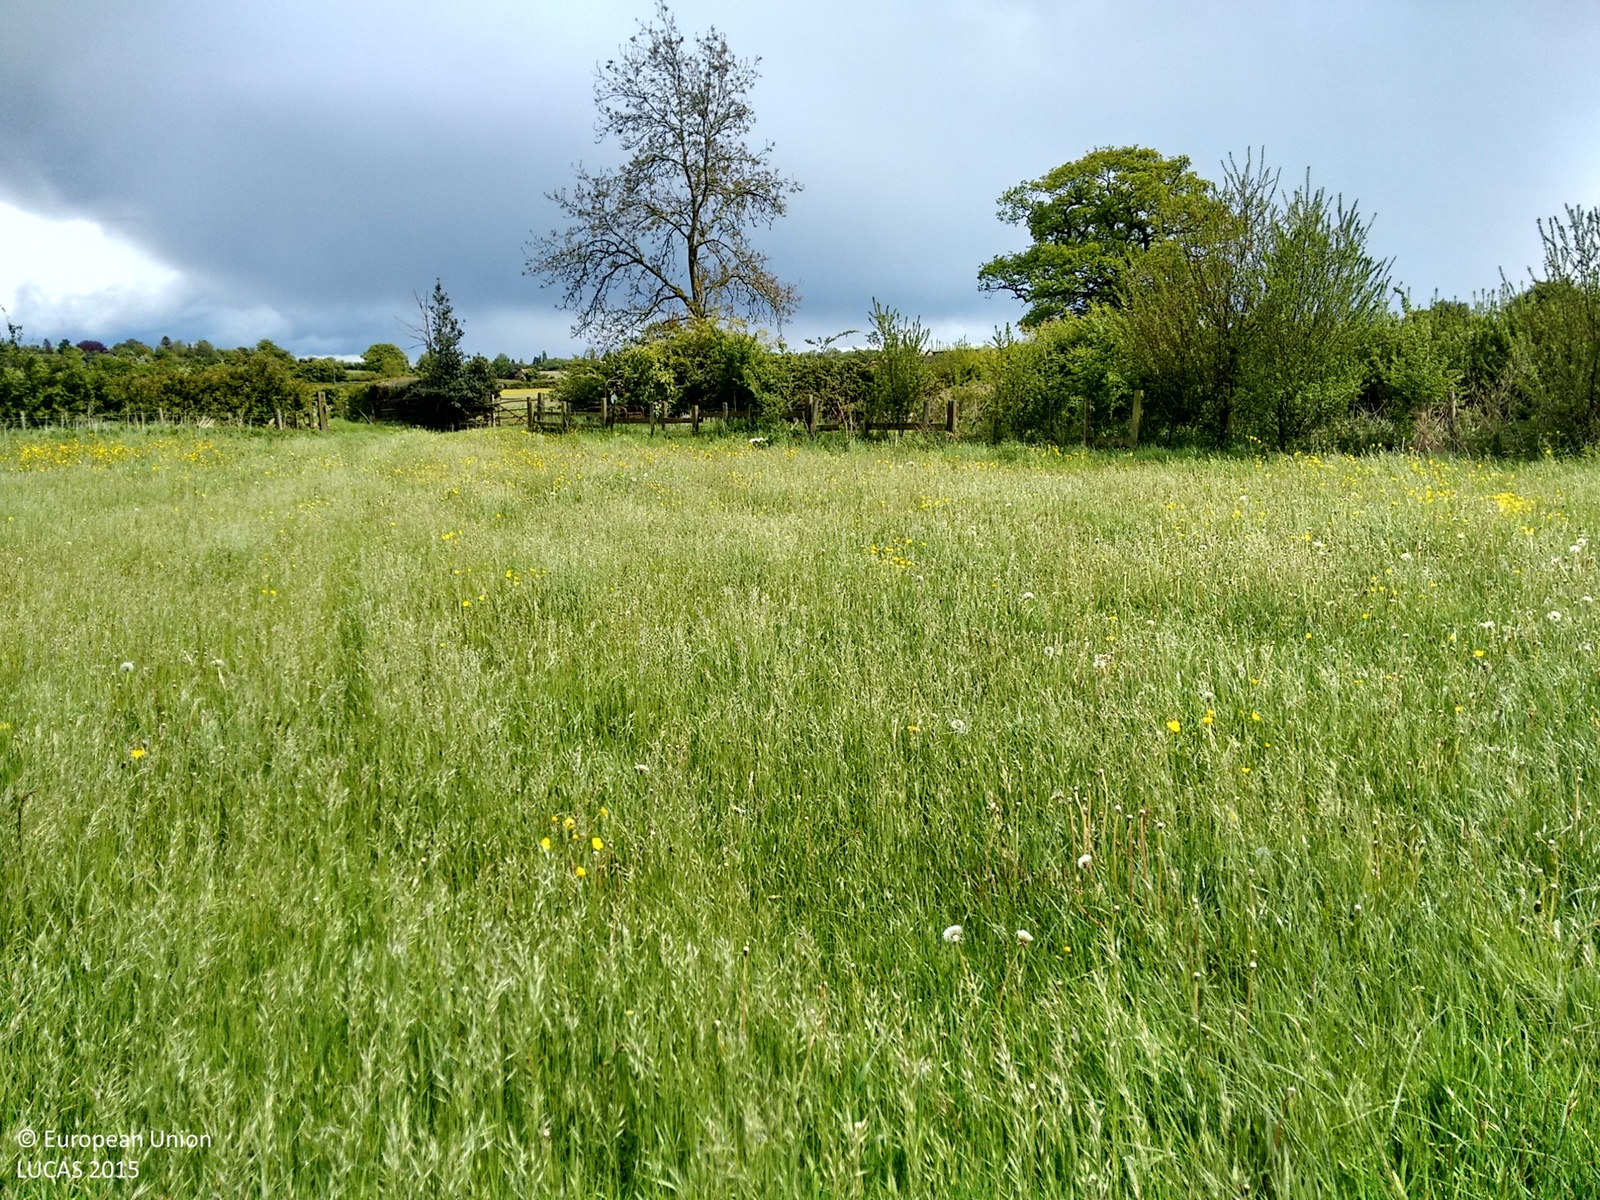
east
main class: Grassland
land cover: Grassland without tree/shrub cover
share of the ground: > 75 %
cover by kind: herbaceous plants 100 %
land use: Agriculture (excluding fallow land and kitchen gardens)
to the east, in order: Grassland without tree/shrub cover; Fences; Managed hedges; Grassland without tree/shrub cover; Fences; Managed hedges; Grassland without tree/shrub cover
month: May
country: GB
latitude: 52.3447
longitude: -1.4858
